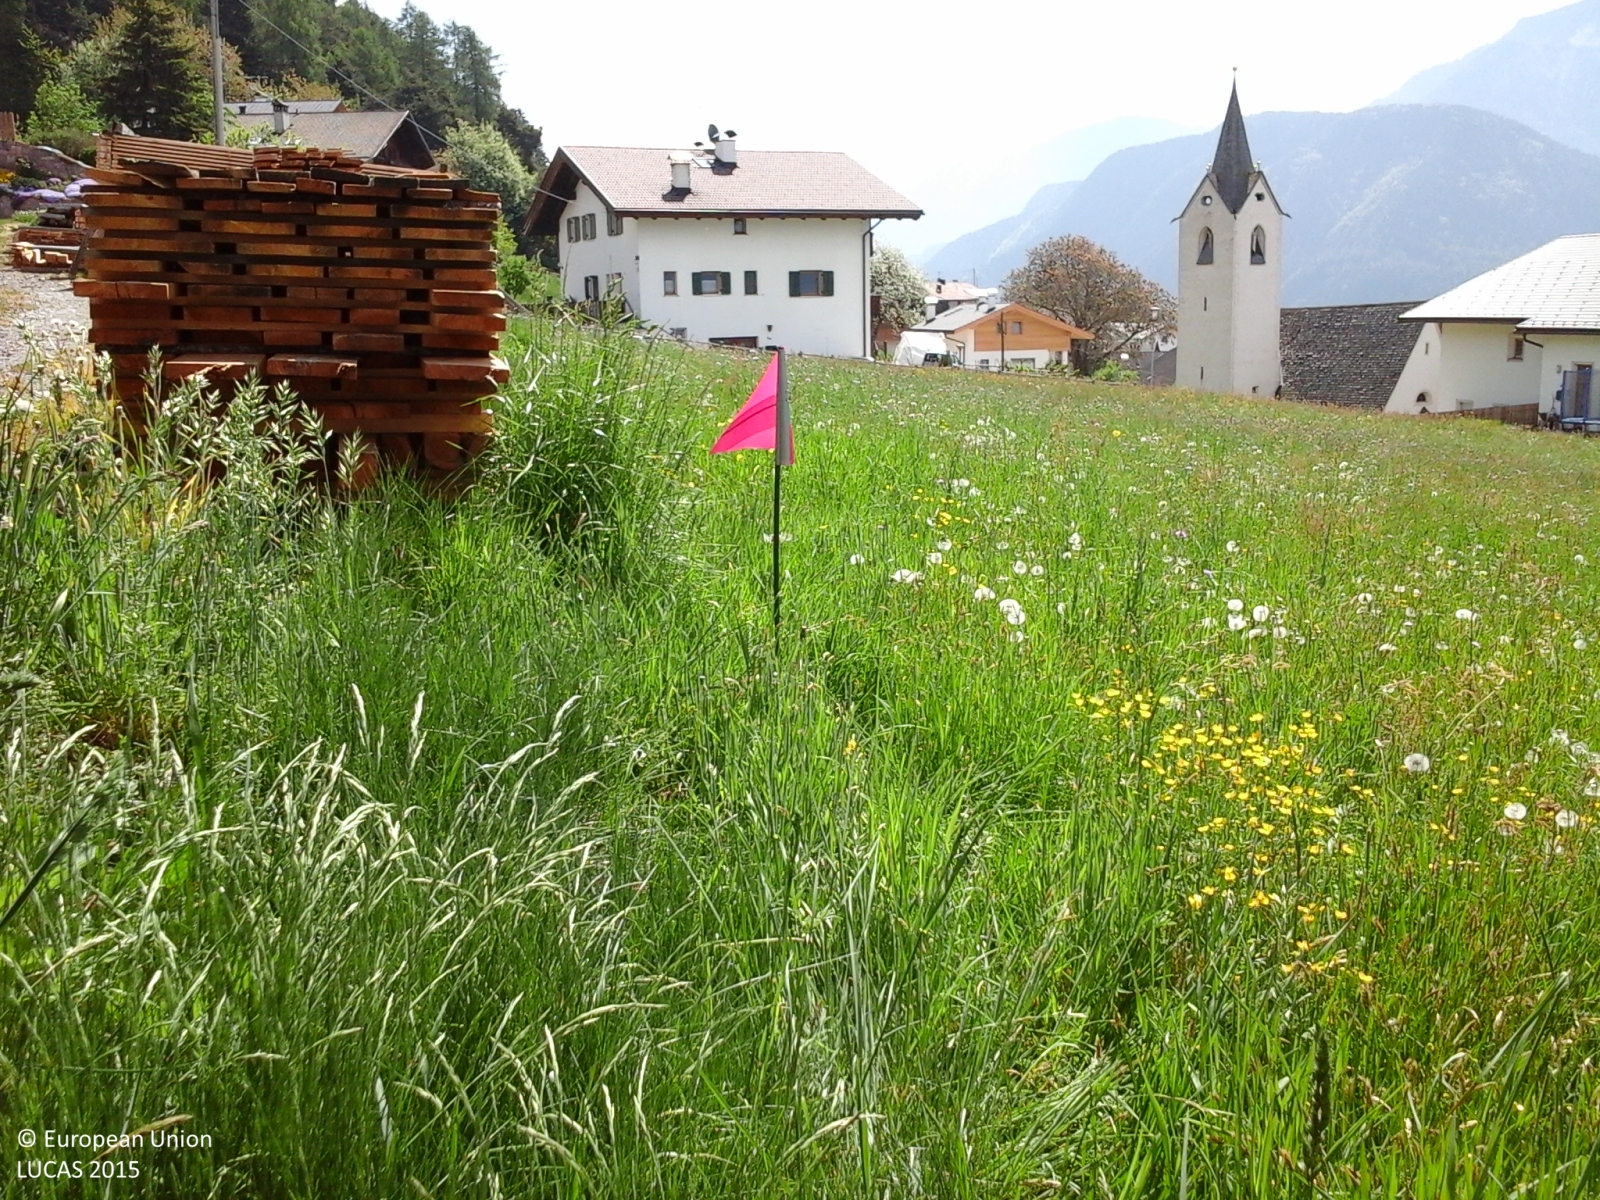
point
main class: Grassland
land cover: Grassland without tree/shrub cover
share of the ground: > 75 %
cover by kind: herbaceous plants 100 %
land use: Agriculture (excluding fallow land and kitchen gardens)
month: May
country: IT
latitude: 46.6098
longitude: 11.5780
